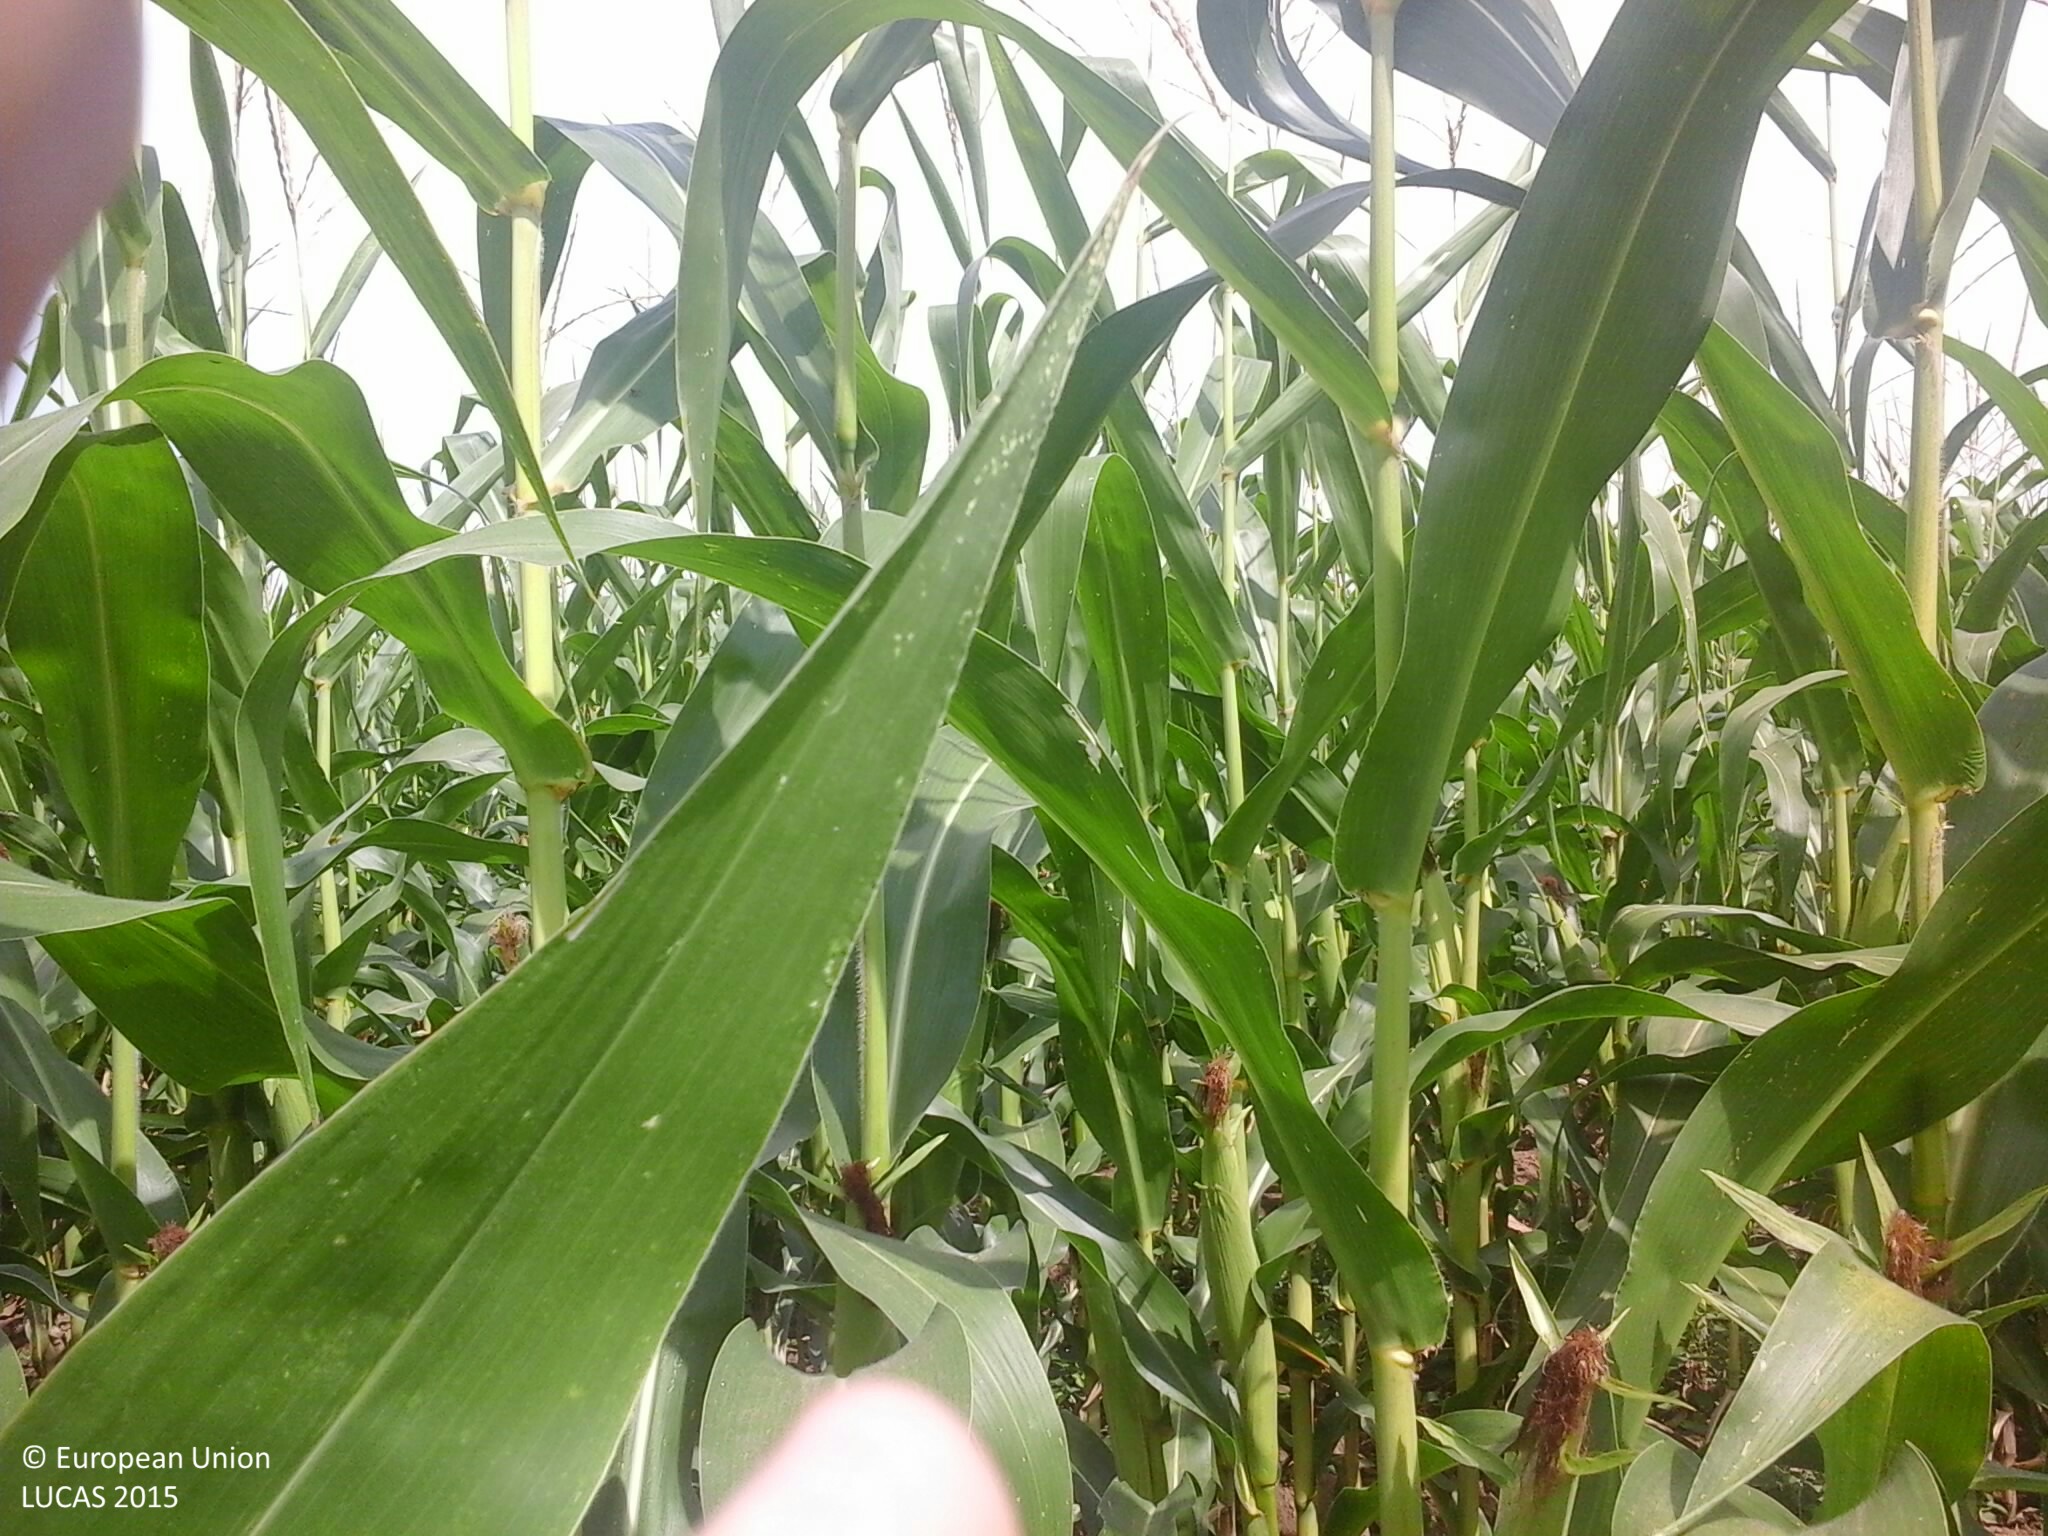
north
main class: Cropland
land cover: Maize
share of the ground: > 75 %
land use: Agriculture (excluding fallow land and kitchen gardens)
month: July
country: HU
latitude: 48.2801
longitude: 22.2797
